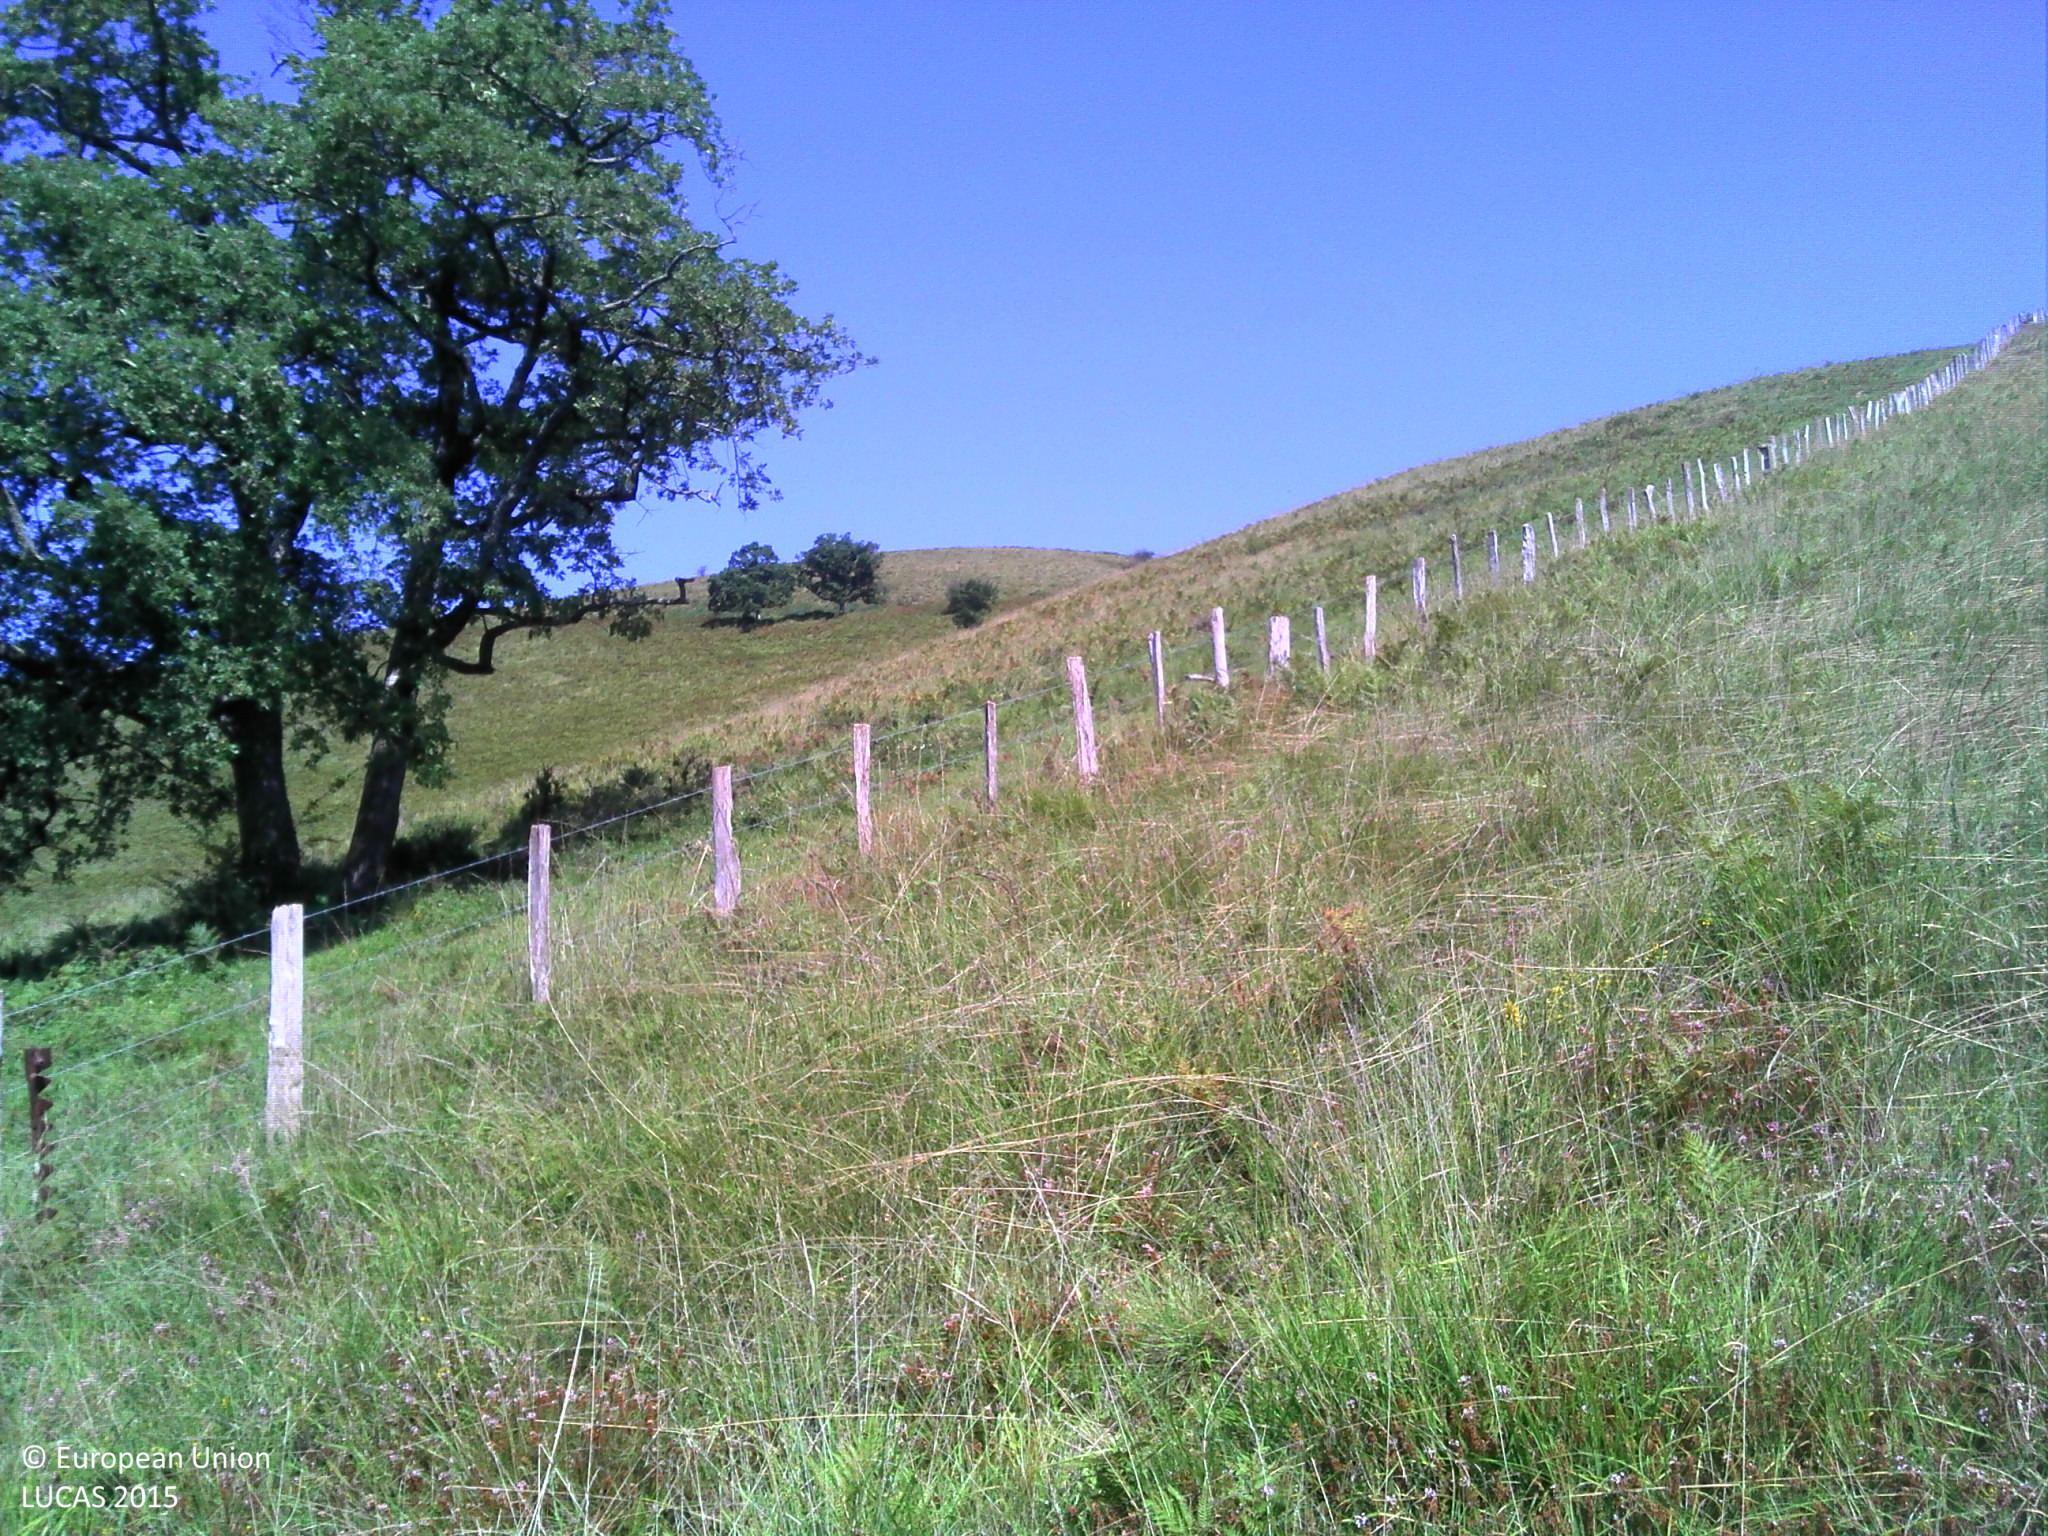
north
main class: Grassland
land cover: Grassland without tree/shrub cover
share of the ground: > 75 %
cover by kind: herbaceous plants 100 %
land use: Agriculture (excluding fallow land and kitchen gardens)
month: September
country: FR
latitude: 43.2195
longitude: -1.1541
